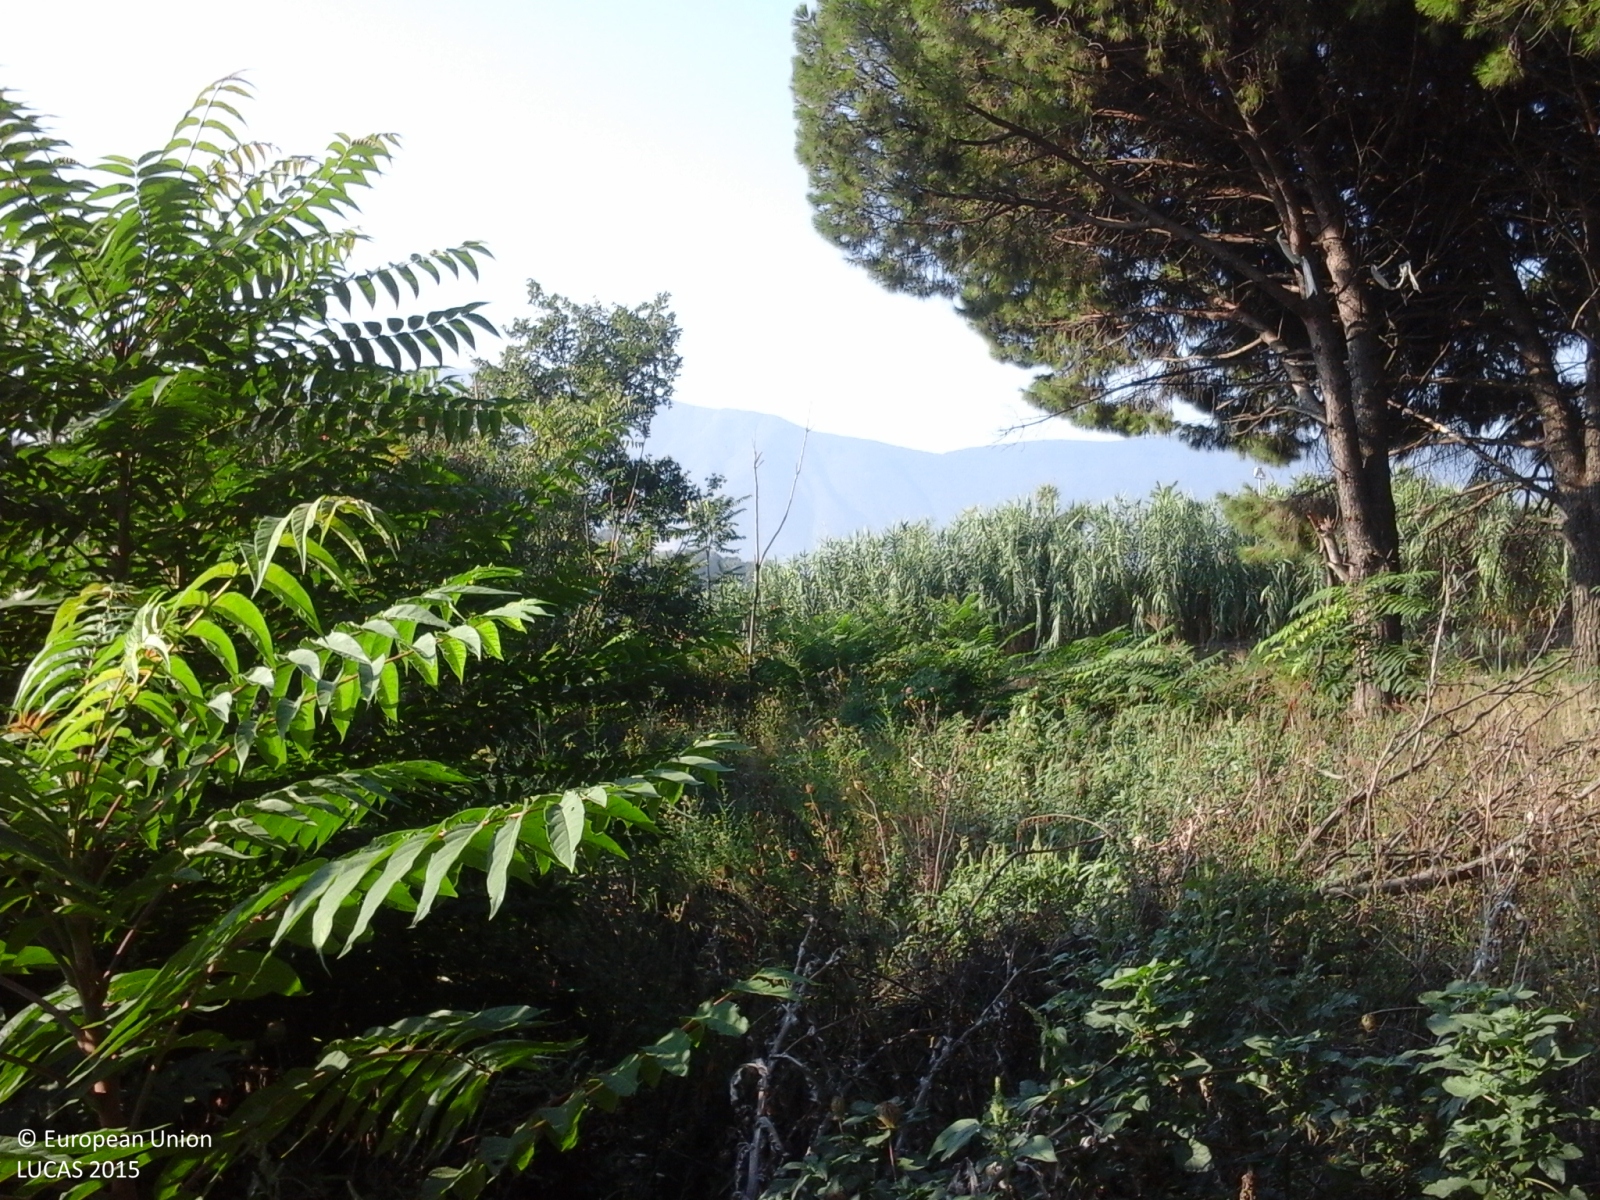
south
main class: Shrubland
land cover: Shrubland with sparse tree cover
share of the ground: > 75 %
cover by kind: shrubs 50 %, herbaceous plants 30 %, broadleaved forest trees 5 %
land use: Semi-natural and natural areas not in use
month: September
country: IT
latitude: 40.7727
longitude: 14.6607
